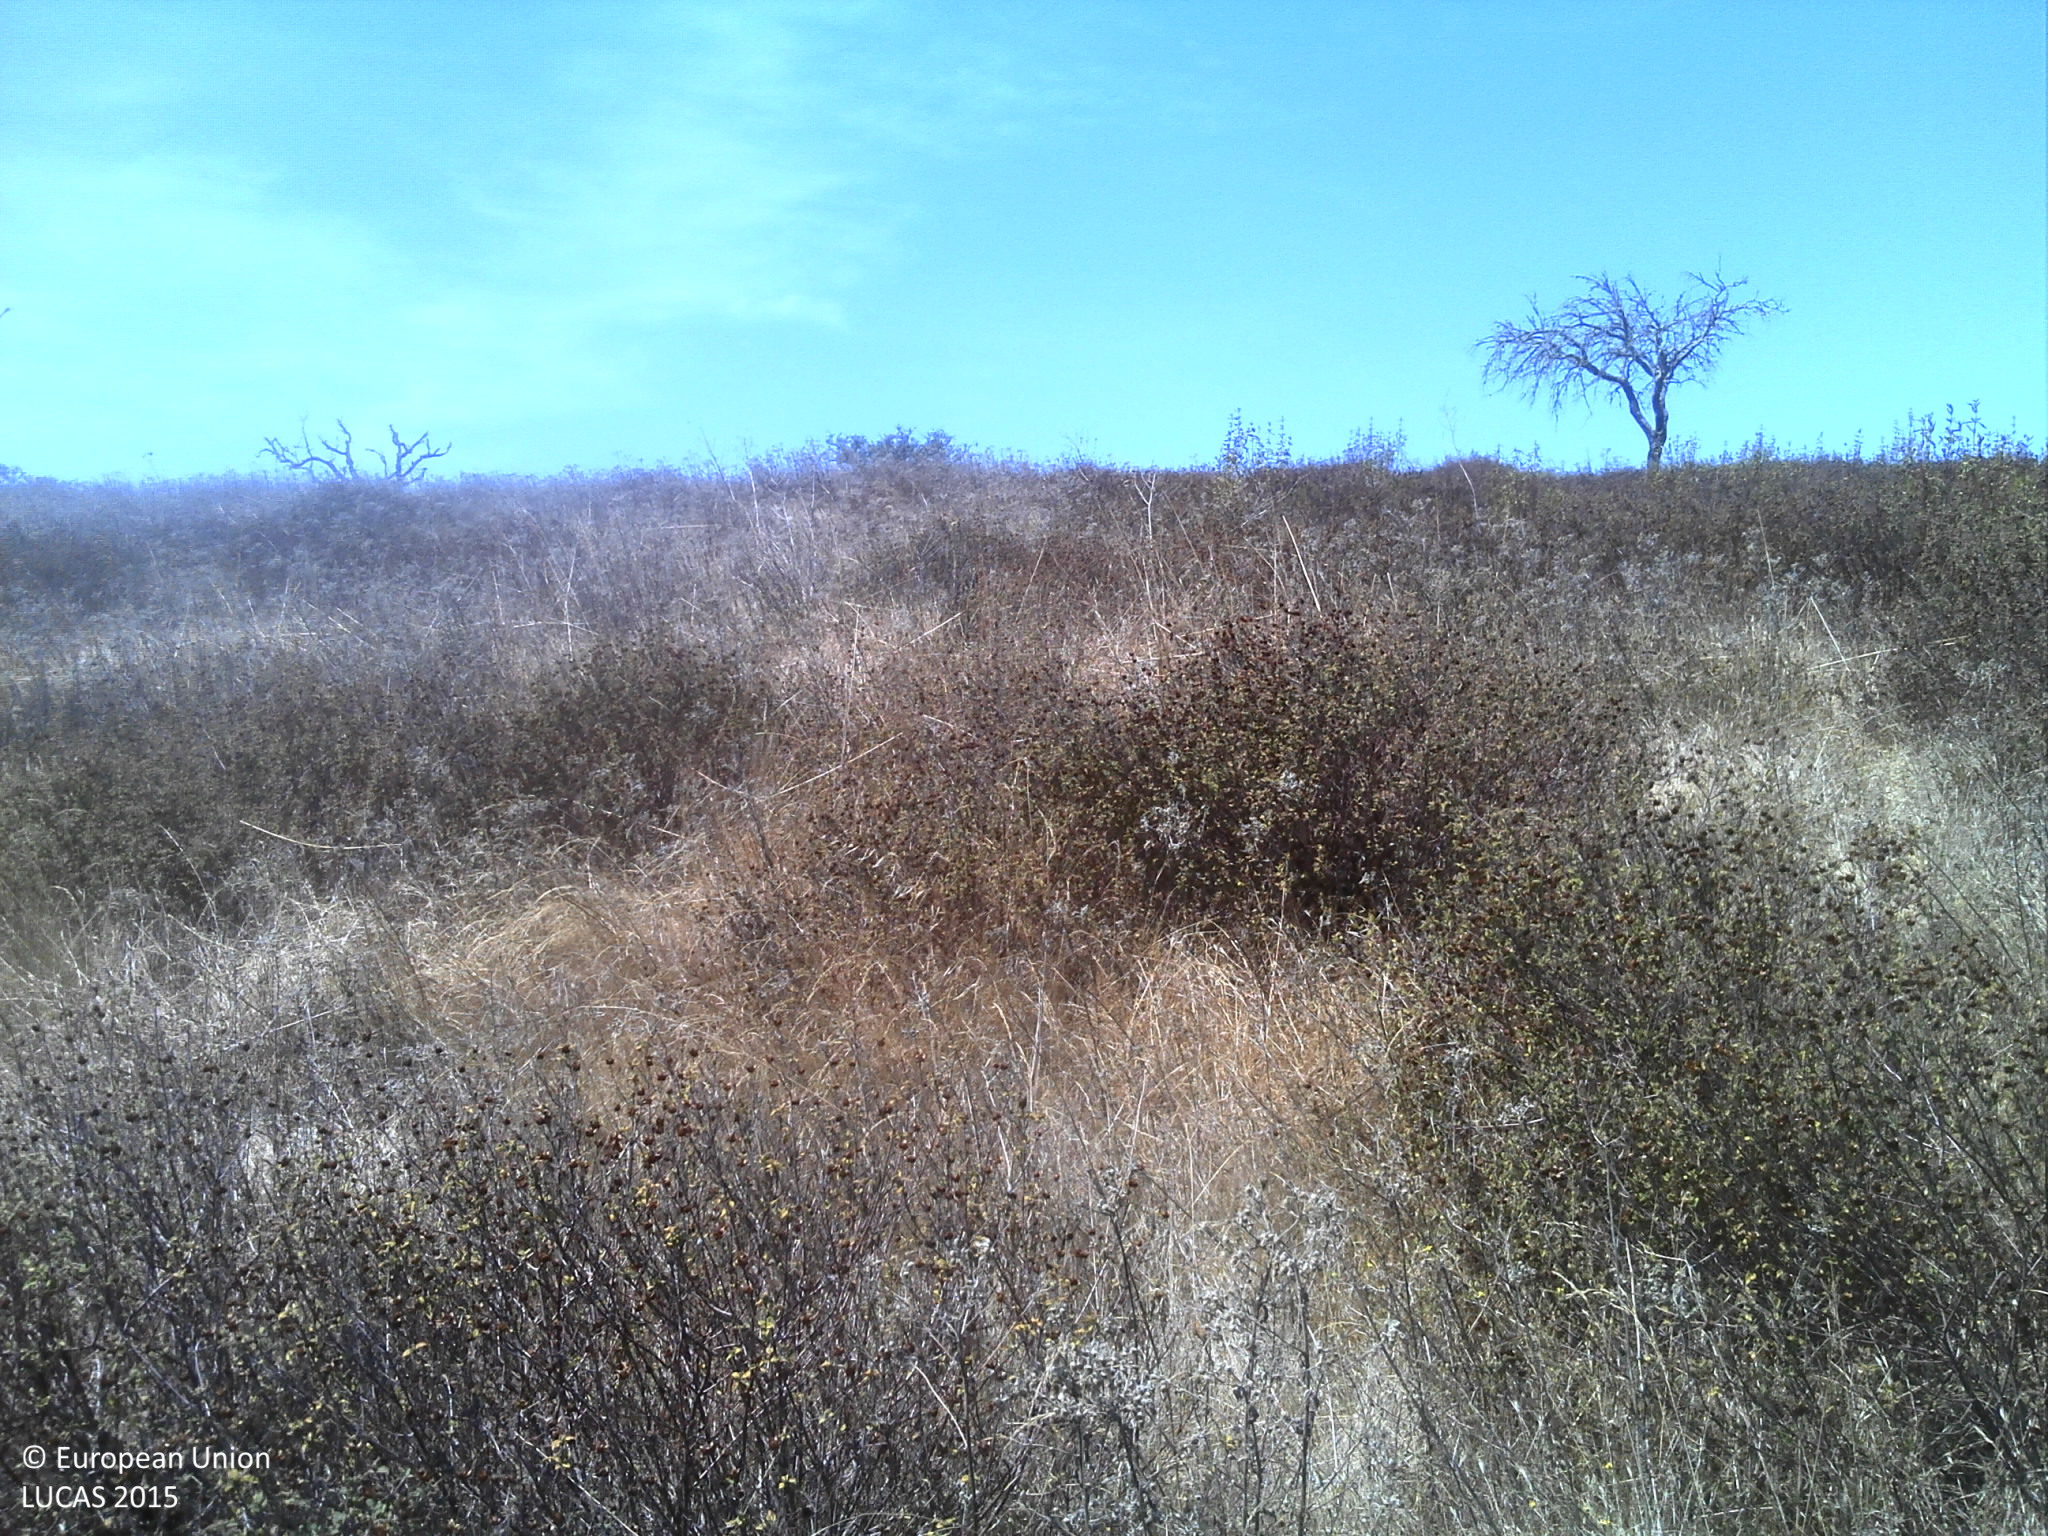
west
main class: Grassland
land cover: Grassland without tree/shrub cover
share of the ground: > 75 %
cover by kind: herbaceous plants 75 %, unconsolidated bare surface 25 %
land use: Agriculture (excluding fallow land and kitchen gardens)
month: August
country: PT
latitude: 37.5247
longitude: -8.2327
